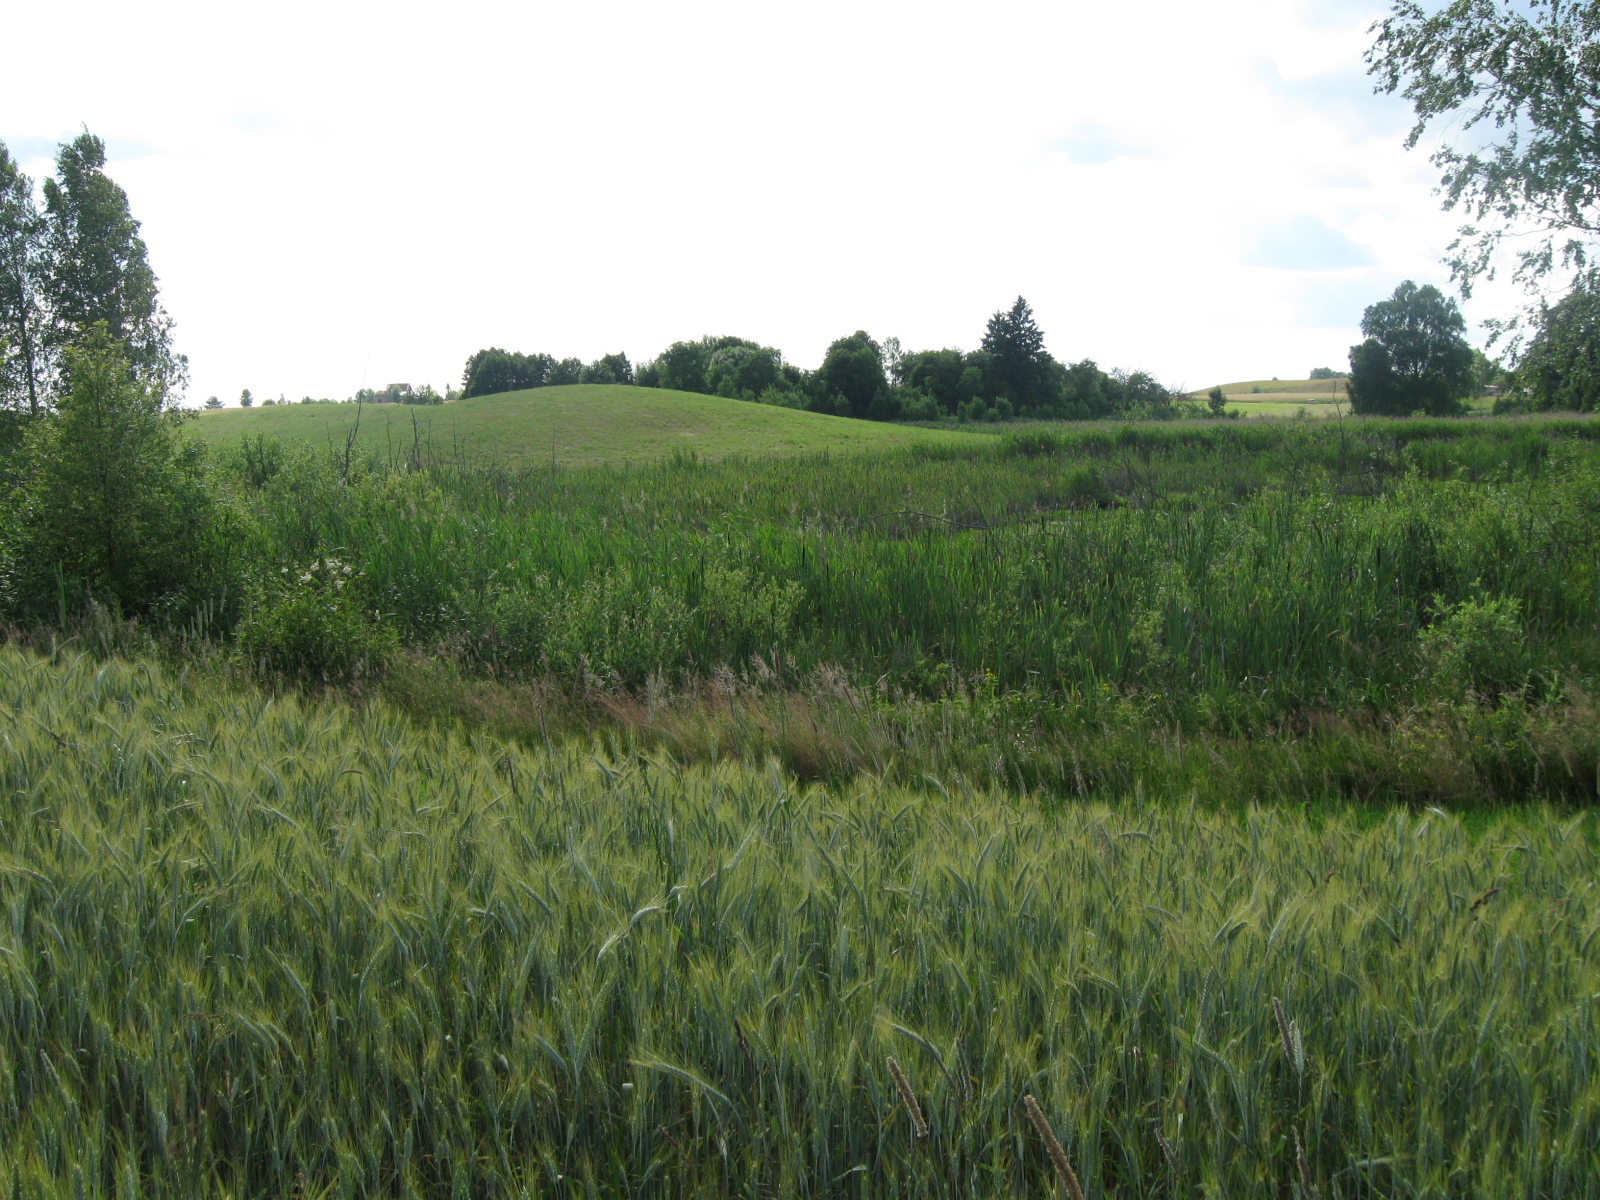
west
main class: Cropland
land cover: Triticale
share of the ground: > 75 %
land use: Agriculture (excluding fallow land and kitchen gardens)
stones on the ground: < 10 %
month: July
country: LT
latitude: 54.2477
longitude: 24.2949
